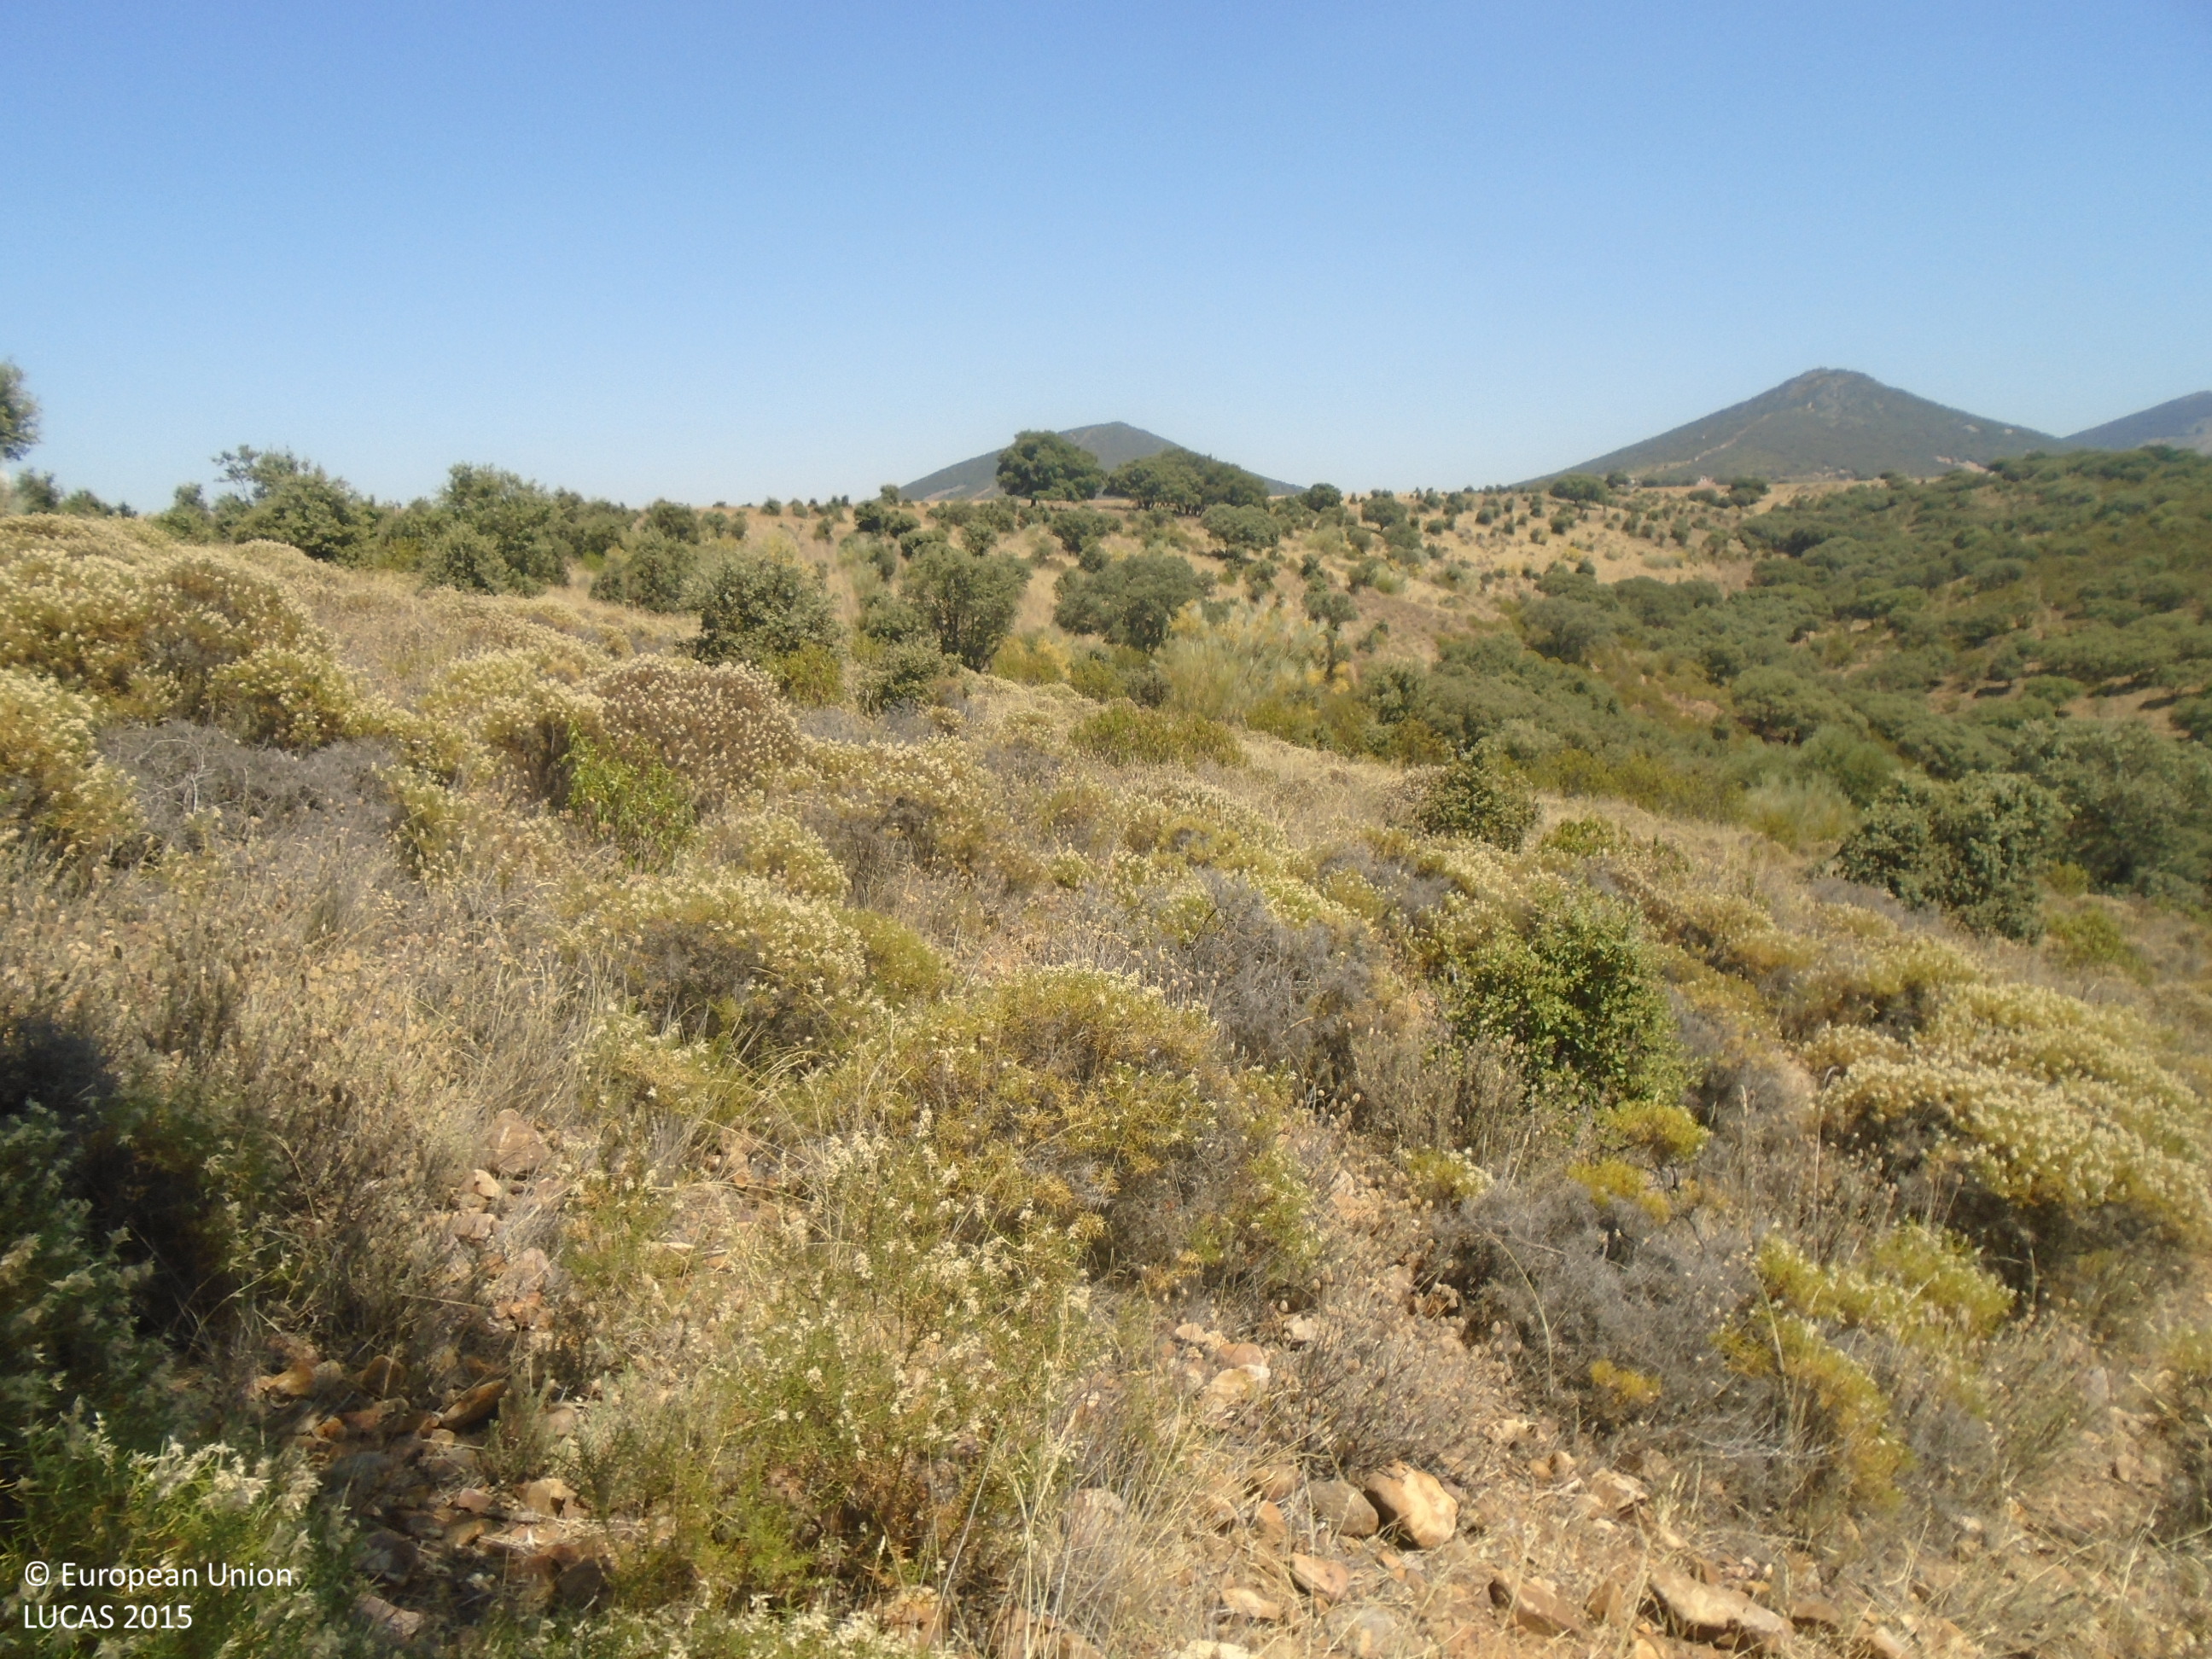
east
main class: Shrubland
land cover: Shrubland with sparse tree cover
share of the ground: > 75 %
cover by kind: shrubs 95 %, broadleaved forest trees 5 %
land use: Semi-natural and natural areas not in use
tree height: > 5 m
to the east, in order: Shrubland with sparse tree cover; Grass margins; Spontaneously vegetated surfaces
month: July
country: ES
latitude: 39.6968
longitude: -4.9852
